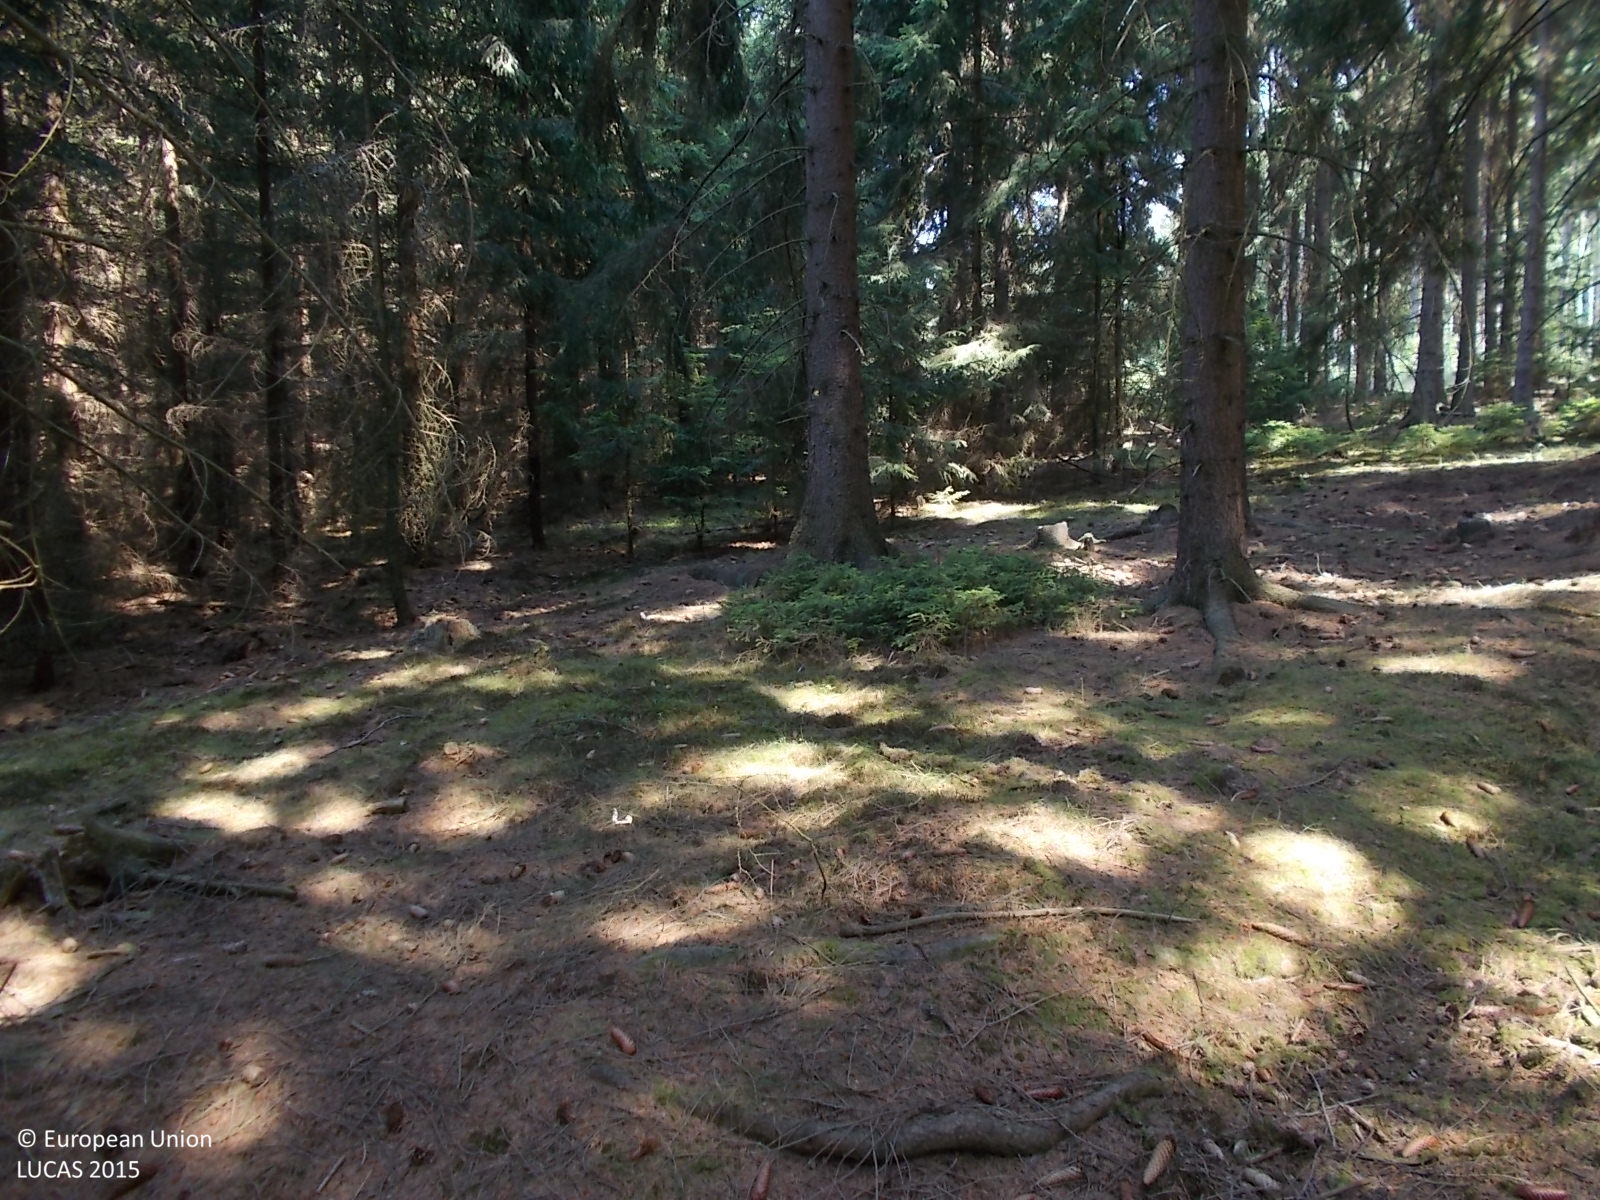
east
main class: Woodland
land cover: Spruce dominated coniferous woodland
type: hemiboreal forest and nemoral coniferous forest and mixed broadleaved-coniferous forest
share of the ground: > 75 %
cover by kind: coniferous forest trees 70 %, unconsolidated bare surface 20 %, herbaceous plants 5 %, lichens and mosses 5 %
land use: Forestry
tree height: > 5 m
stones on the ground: < 10 %
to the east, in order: Spruce dominated coniferous woodland; Other coniferous woodland; Spruce dominated coniferous woodland
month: July
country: CZ
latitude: 50.1033
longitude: 13.7895
